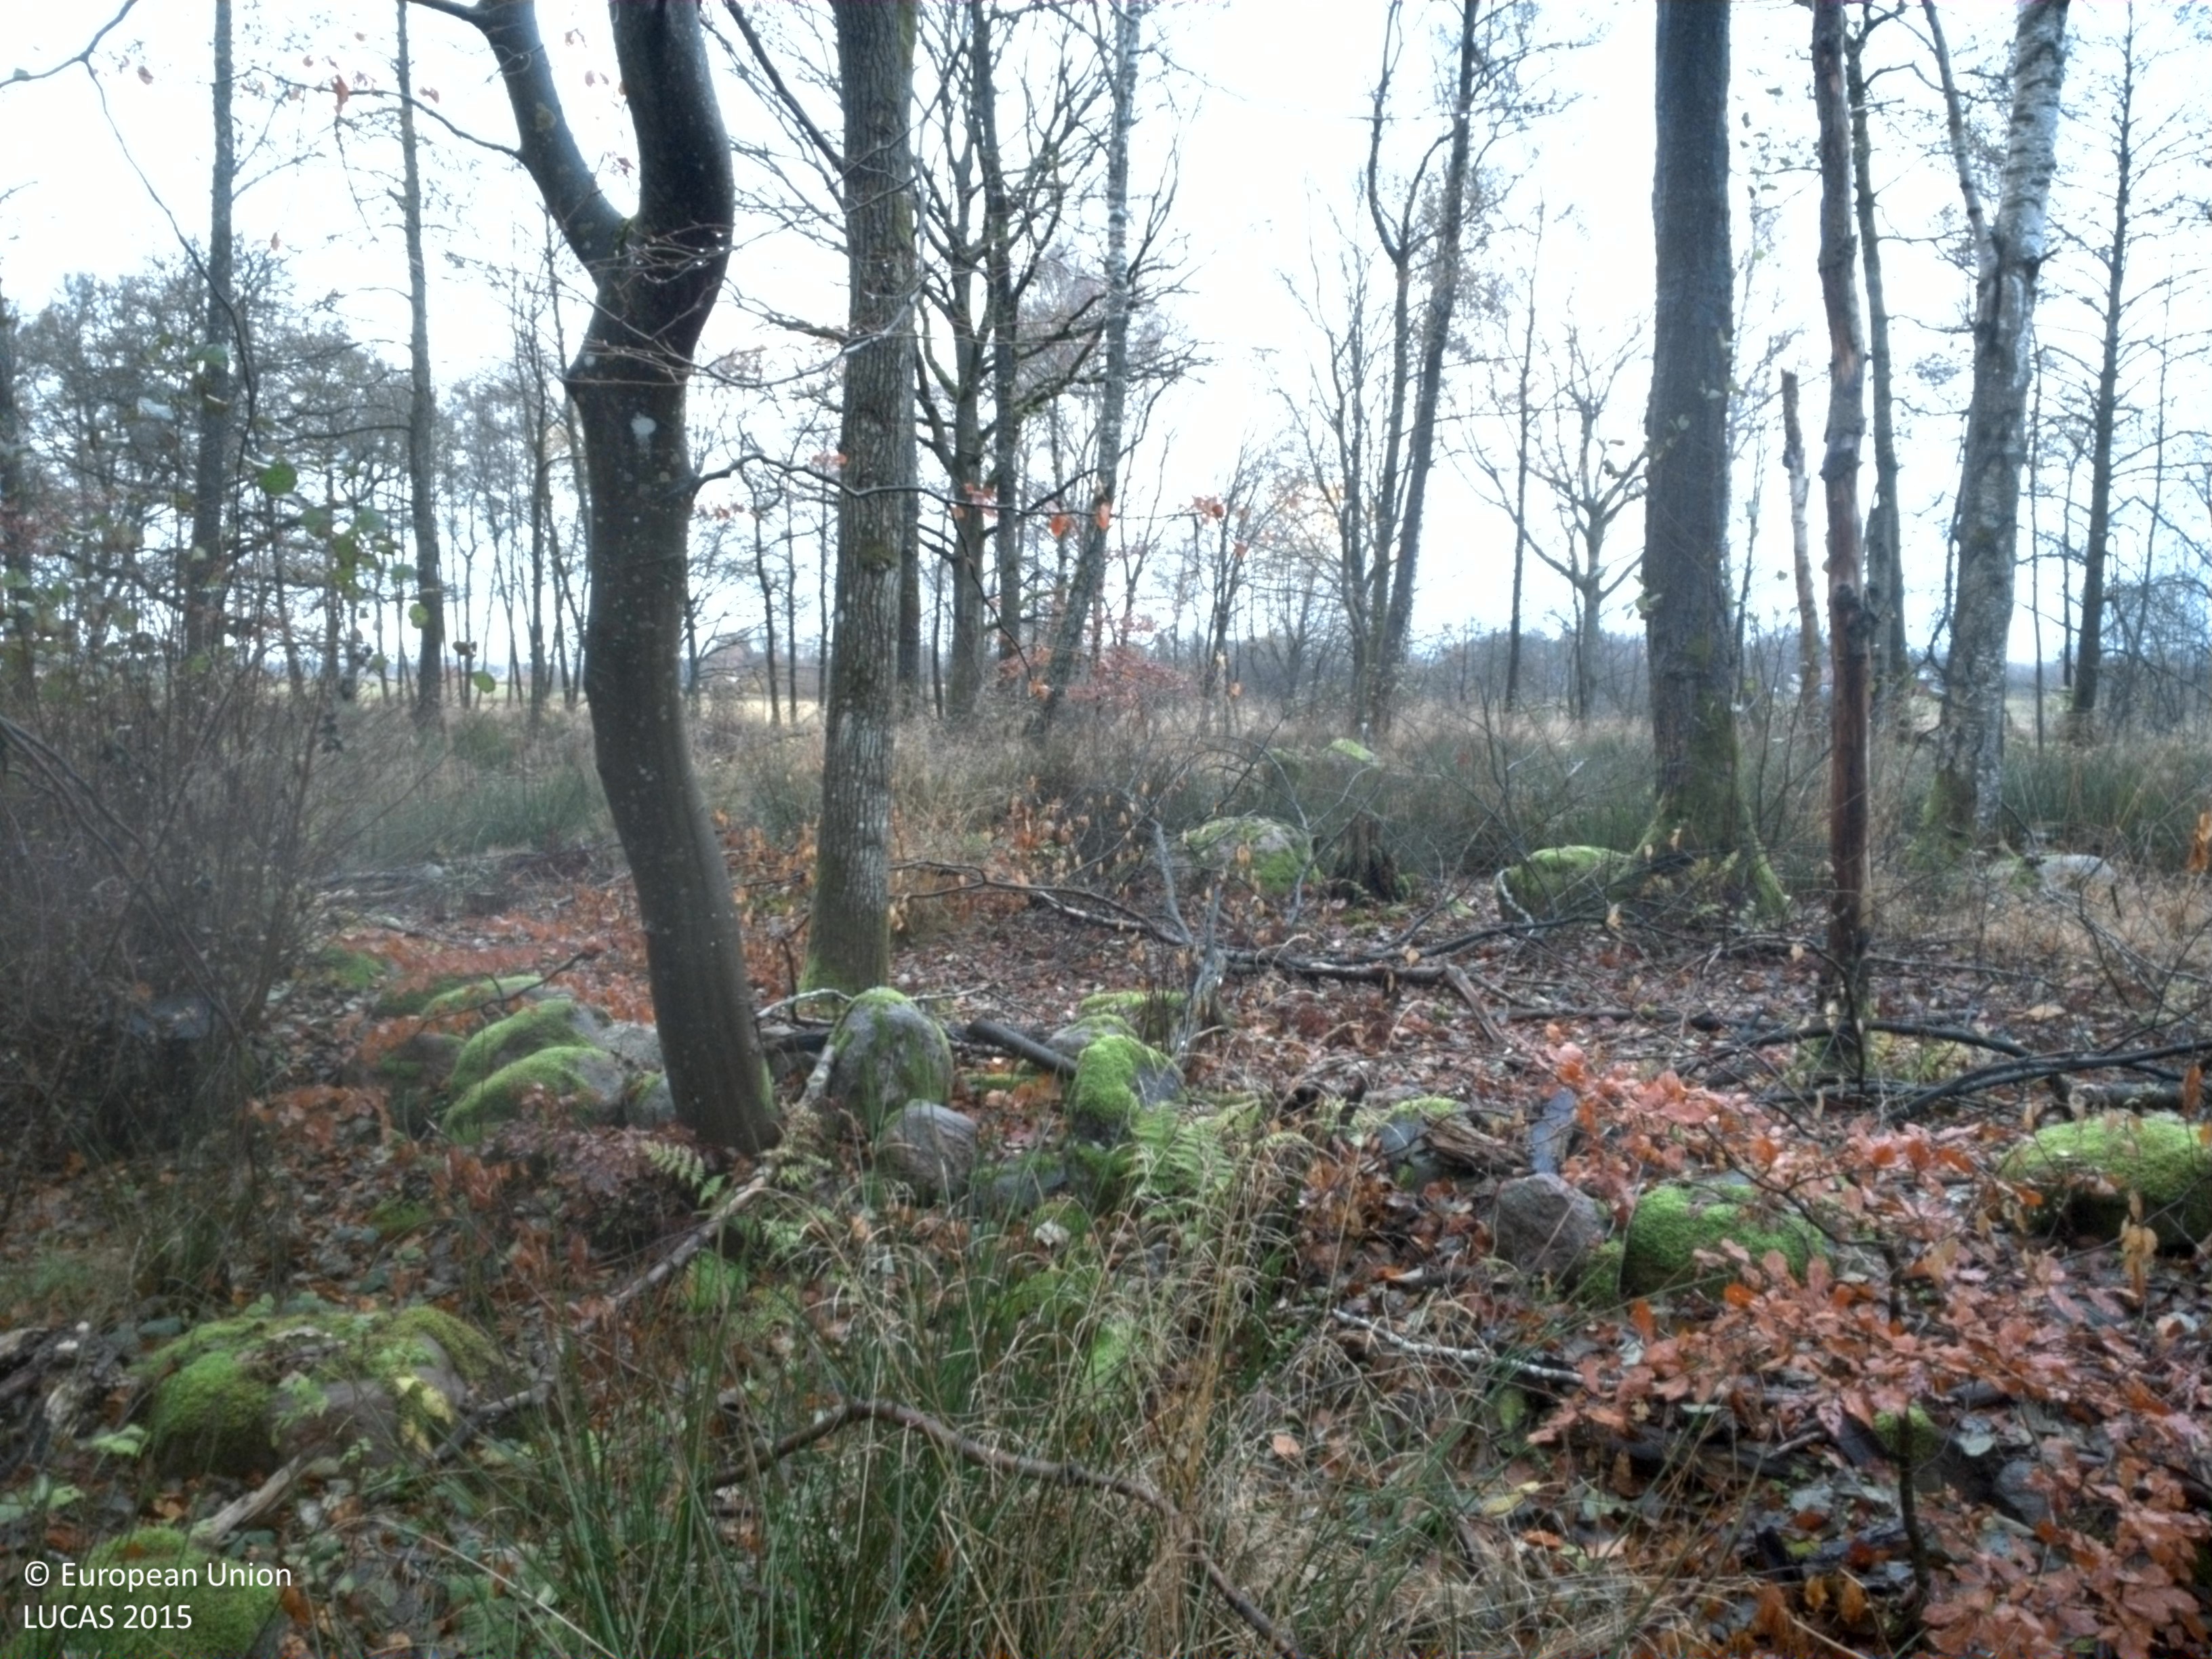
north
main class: Woodland
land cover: Broadleaved woodland
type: hemiboreal forest and nemoral coniferous forest and mixed broadleaved-coniferous forest
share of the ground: 50 - 75 %
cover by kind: broadleaved forest trees 55 %, herbaceous plants 35 %, shrubs 10 %
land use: Forestry
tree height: > 5 m
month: November
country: SE
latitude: 56.0769
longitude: 13.1626
